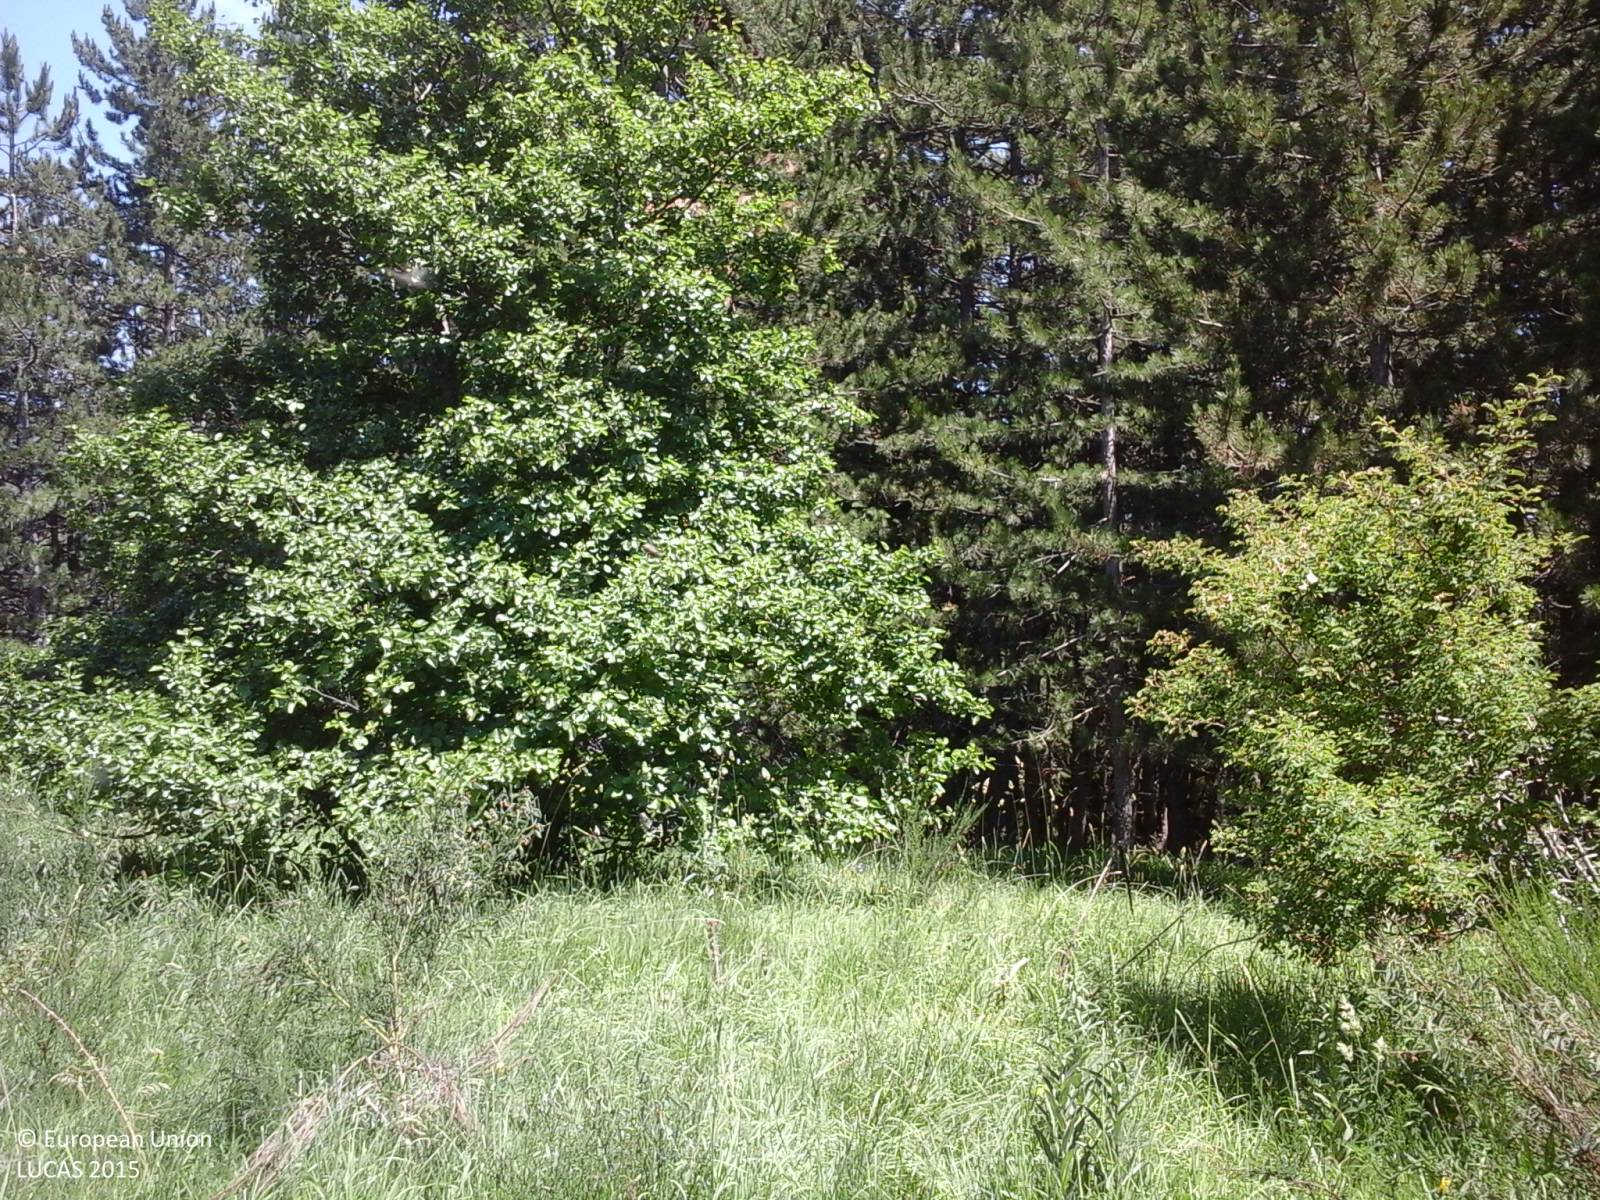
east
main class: Shrubland
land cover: Shrubland with sparse tree cover
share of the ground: > 75 %
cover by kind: shrubs 60 %, herbaceous plants 35 %, broadleaved forest trees 5 %
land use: Semi-natural and natural areas not in use
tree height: > 5 m
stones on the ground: < 10 %
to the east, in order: Shrubland with sparse tree cover; Other coniferous woodland
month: July
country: IT
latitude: 42.5628
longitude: 13.3394
